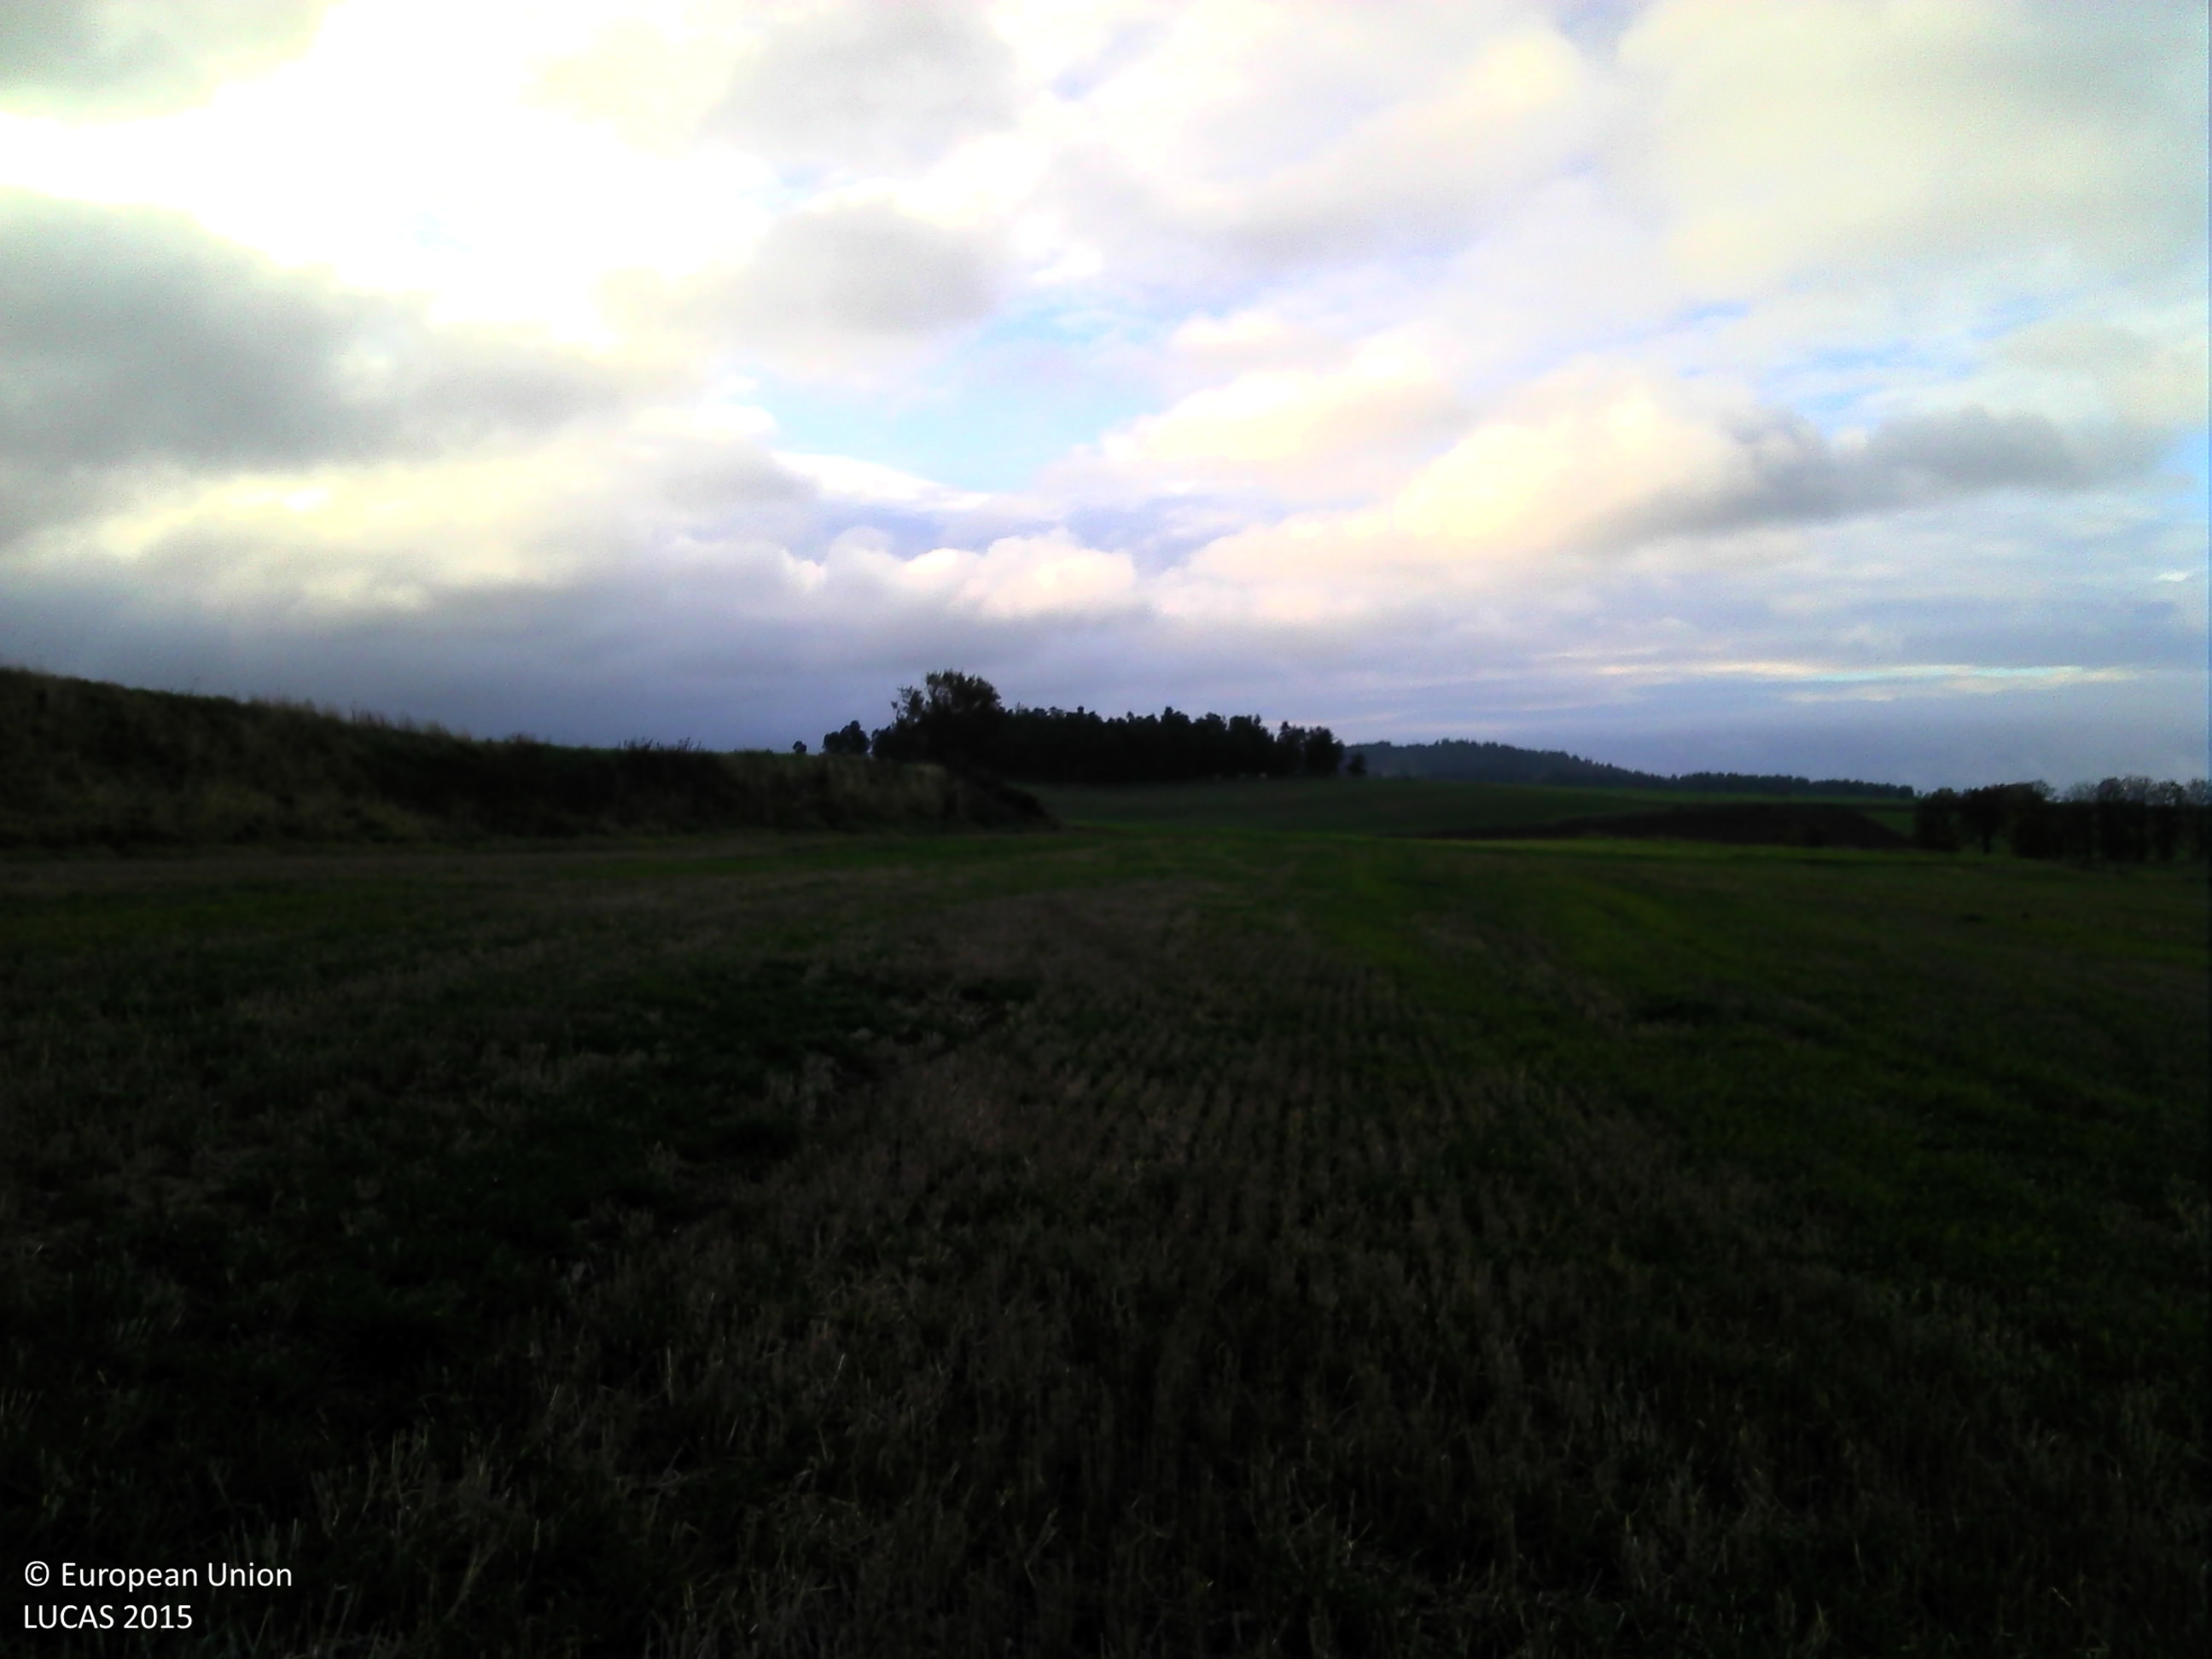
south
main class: Cropland
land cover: Common wheat
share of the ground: 50 - 75 %
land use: Agriculture (excluding fallow land and kitchen gardens)
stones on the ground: < 10 %
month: October
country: FR
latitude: 44.8368
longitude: 3.8442
